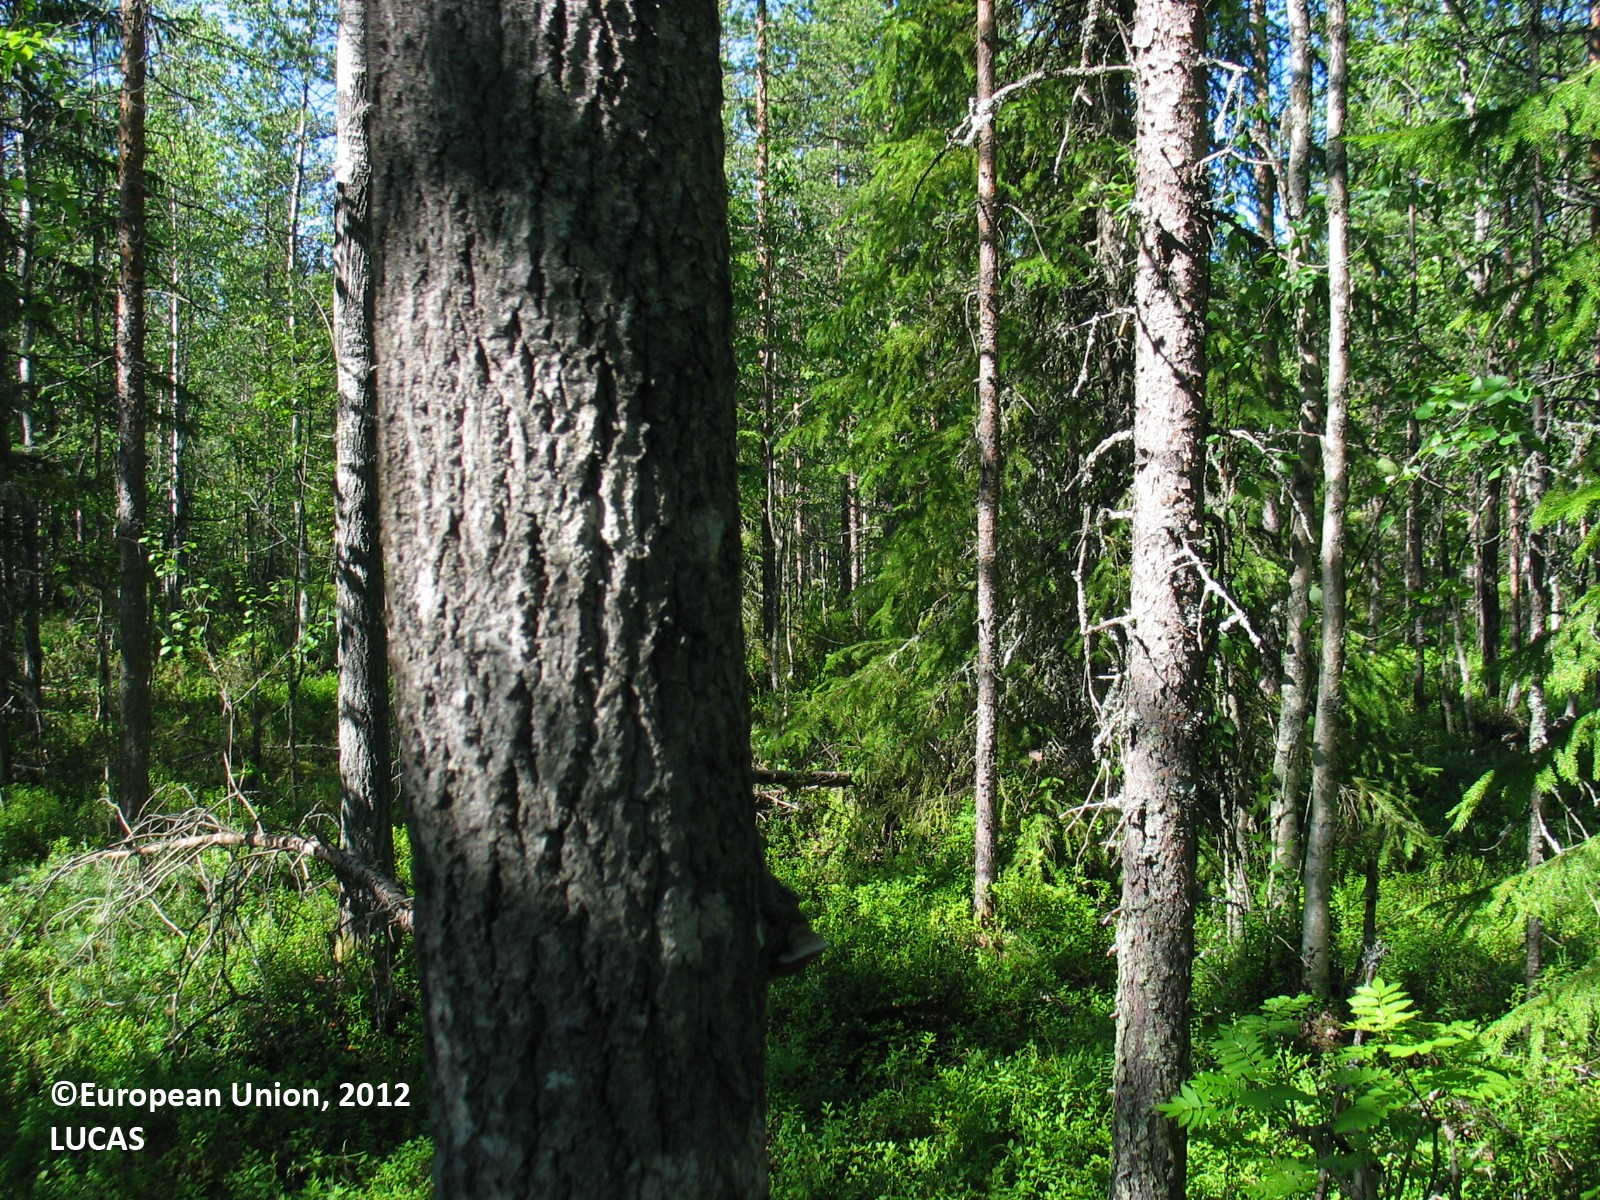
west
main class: Woodland
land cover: Pine dominated mixed woodland
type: boreal forest
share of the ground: 50 - 75 %
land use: Forestry
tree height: > 5 m
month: July
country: FI
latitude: 65.7828
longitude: 25.0297
